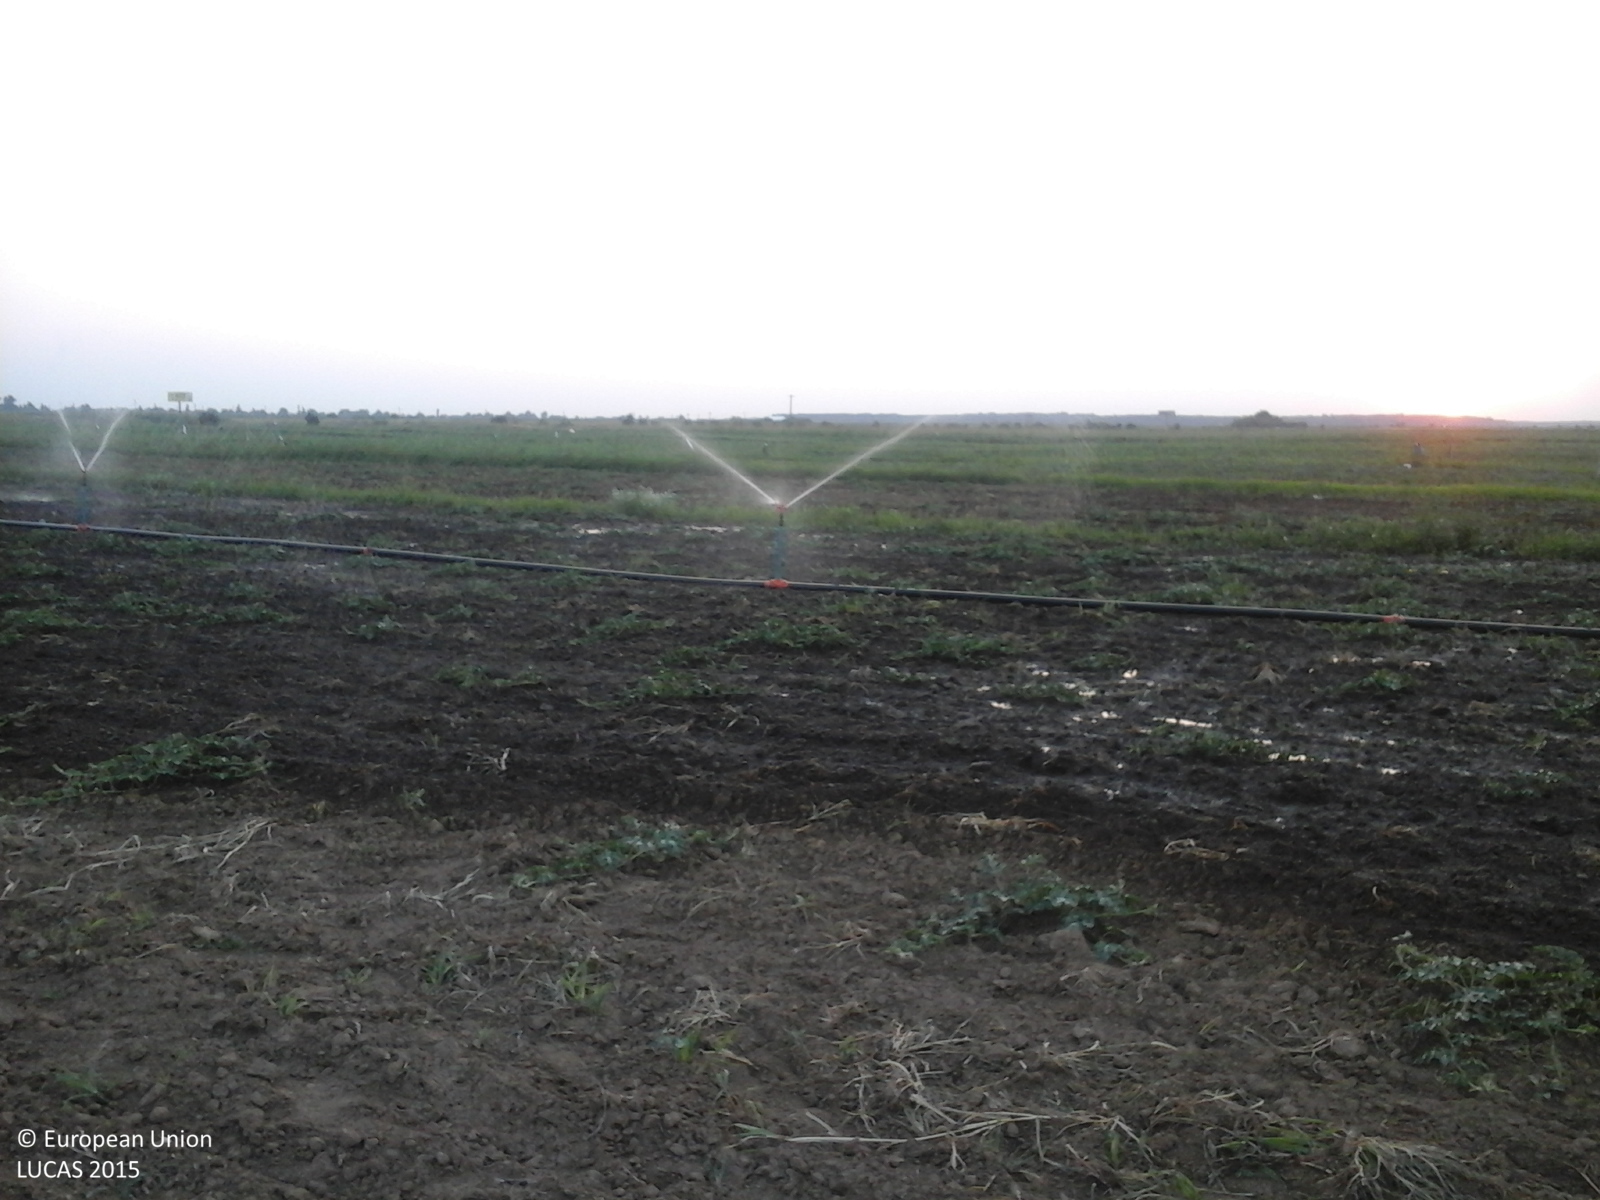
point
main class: Cropland
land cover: Other fresh vegetables
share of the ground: 50 - 75 %
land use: Agriculture (excluding fallow land and kitchen gardens)
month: July
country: RO
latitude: 44.5508
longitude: 25.5128
